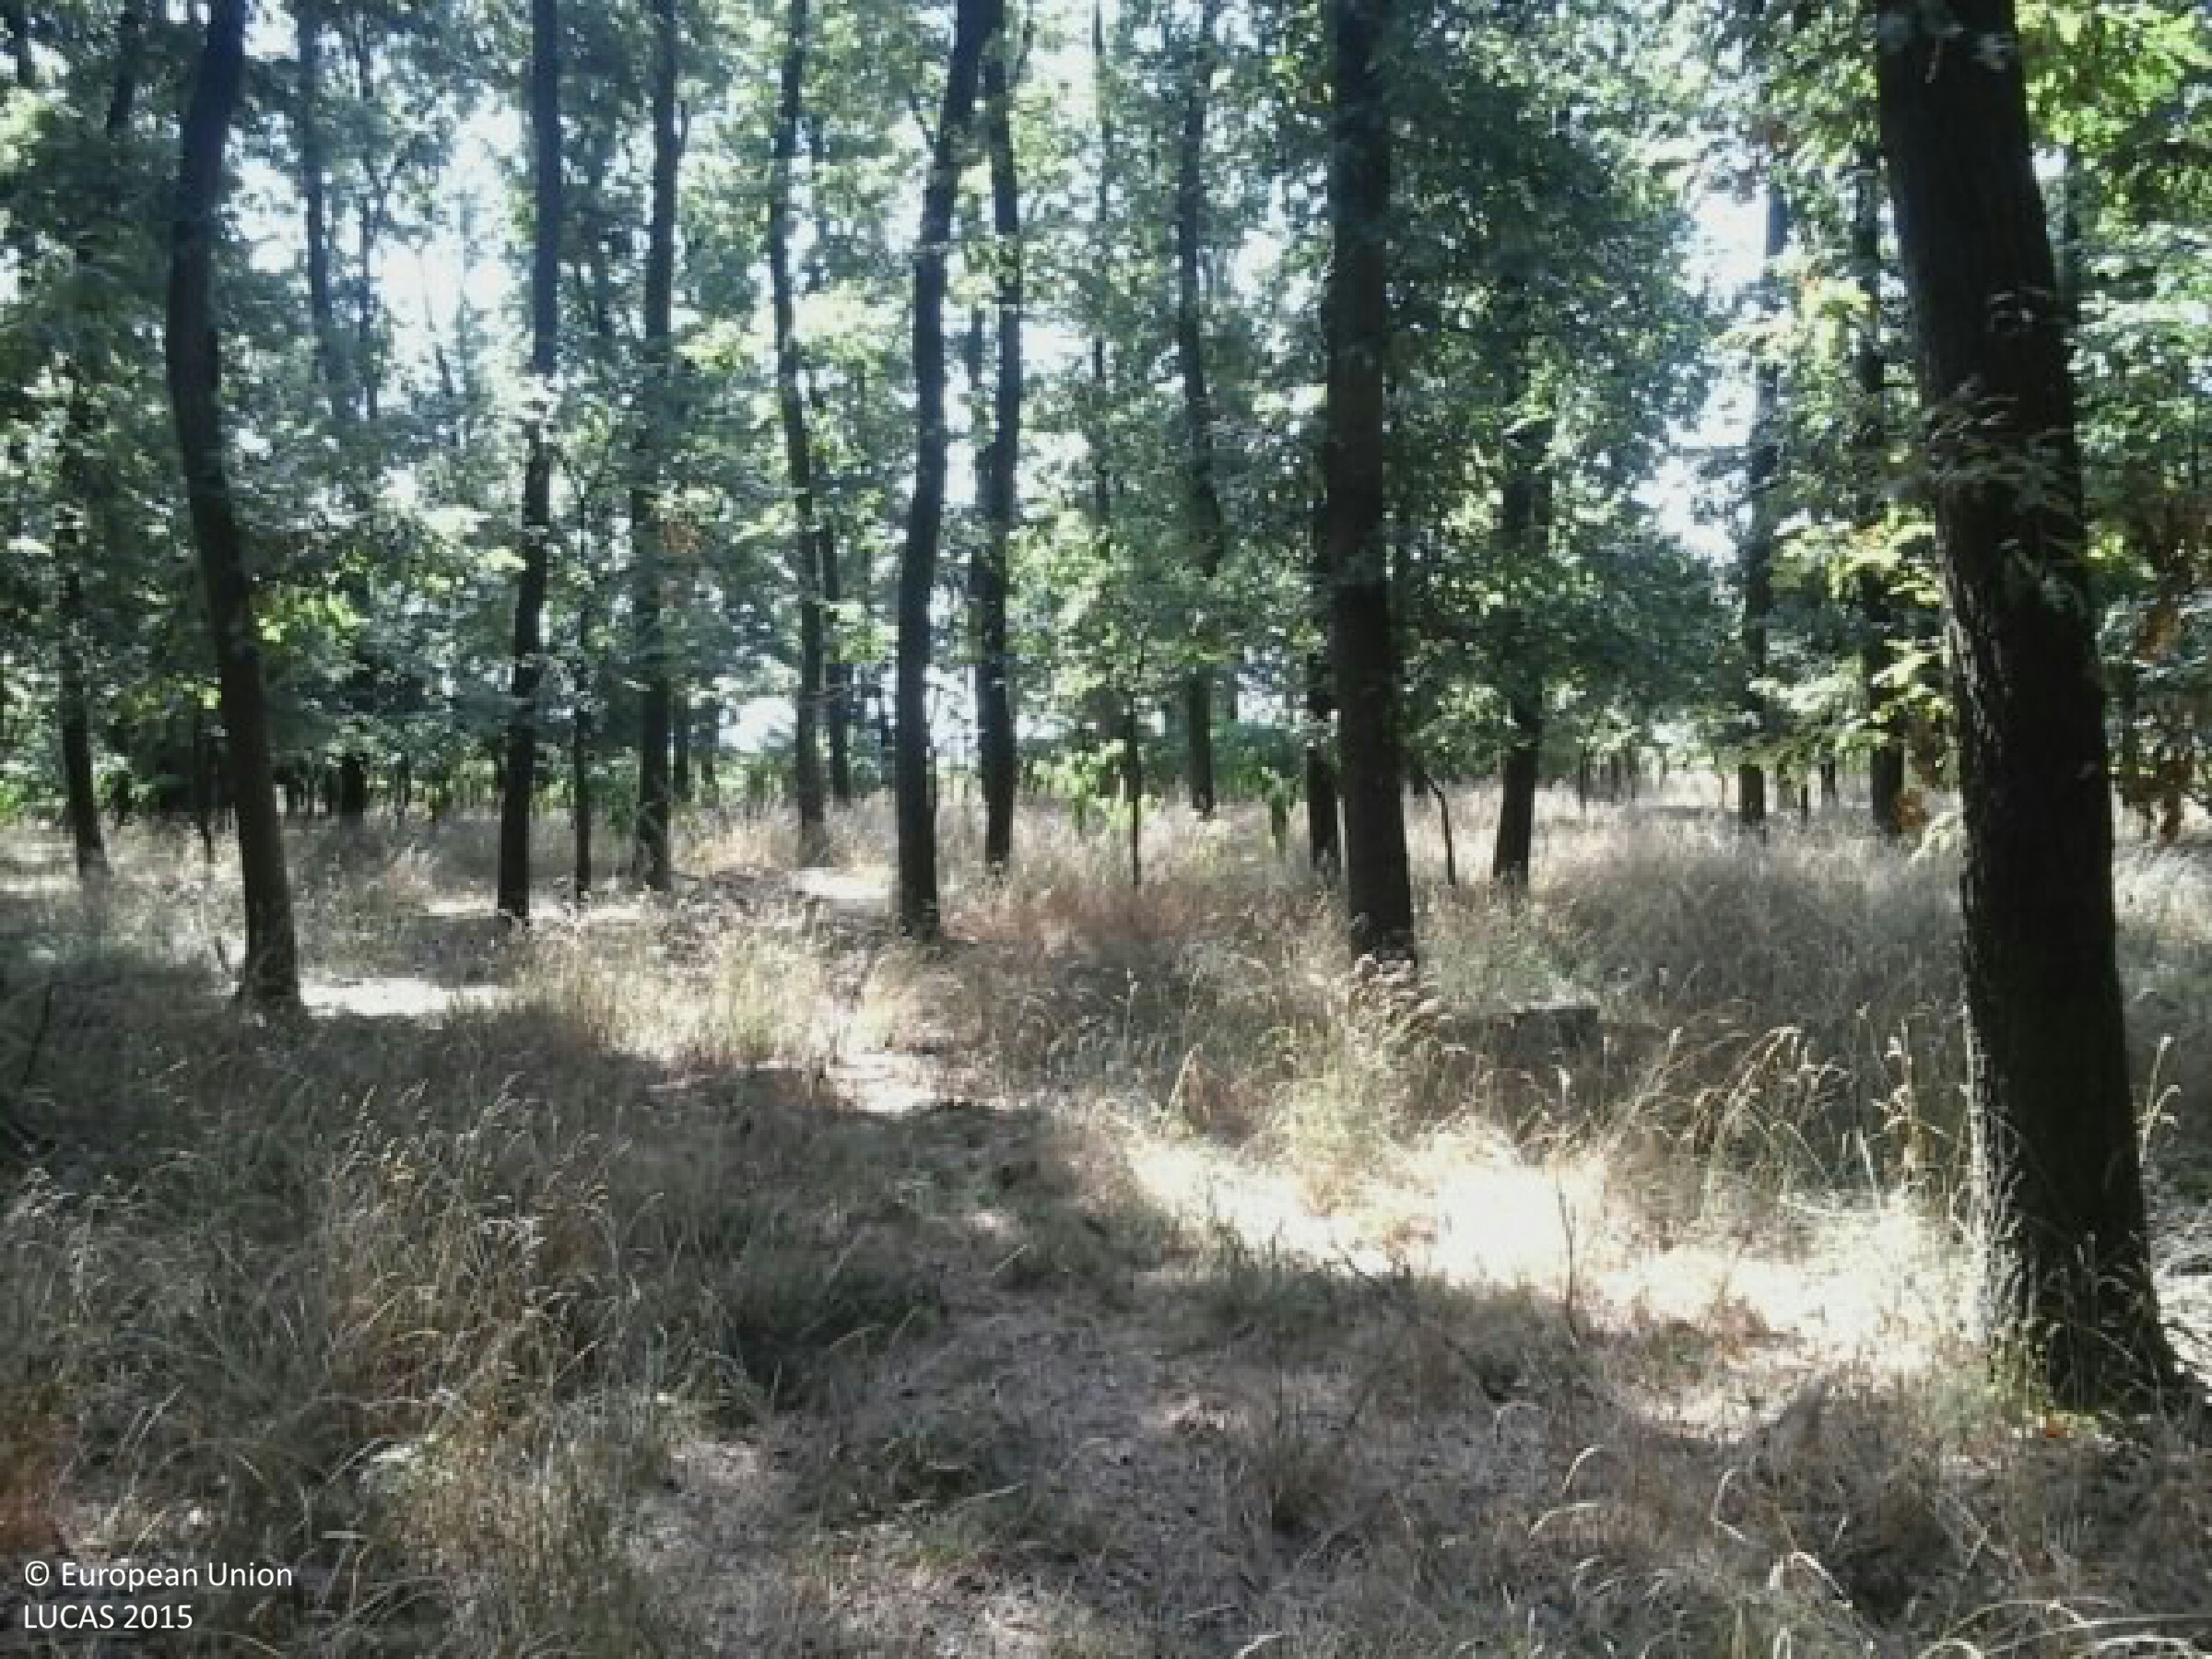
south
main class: Woodland
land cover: Broadleaved woodland
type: mesophytic deciduous forest
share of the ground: > 75 %
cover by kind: broadleaved forest trees 95 %, herbaceous plants 5 %
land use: Forestry
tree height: < 5 m
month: August
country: HU
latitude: 46.5618
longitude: 18.1879
